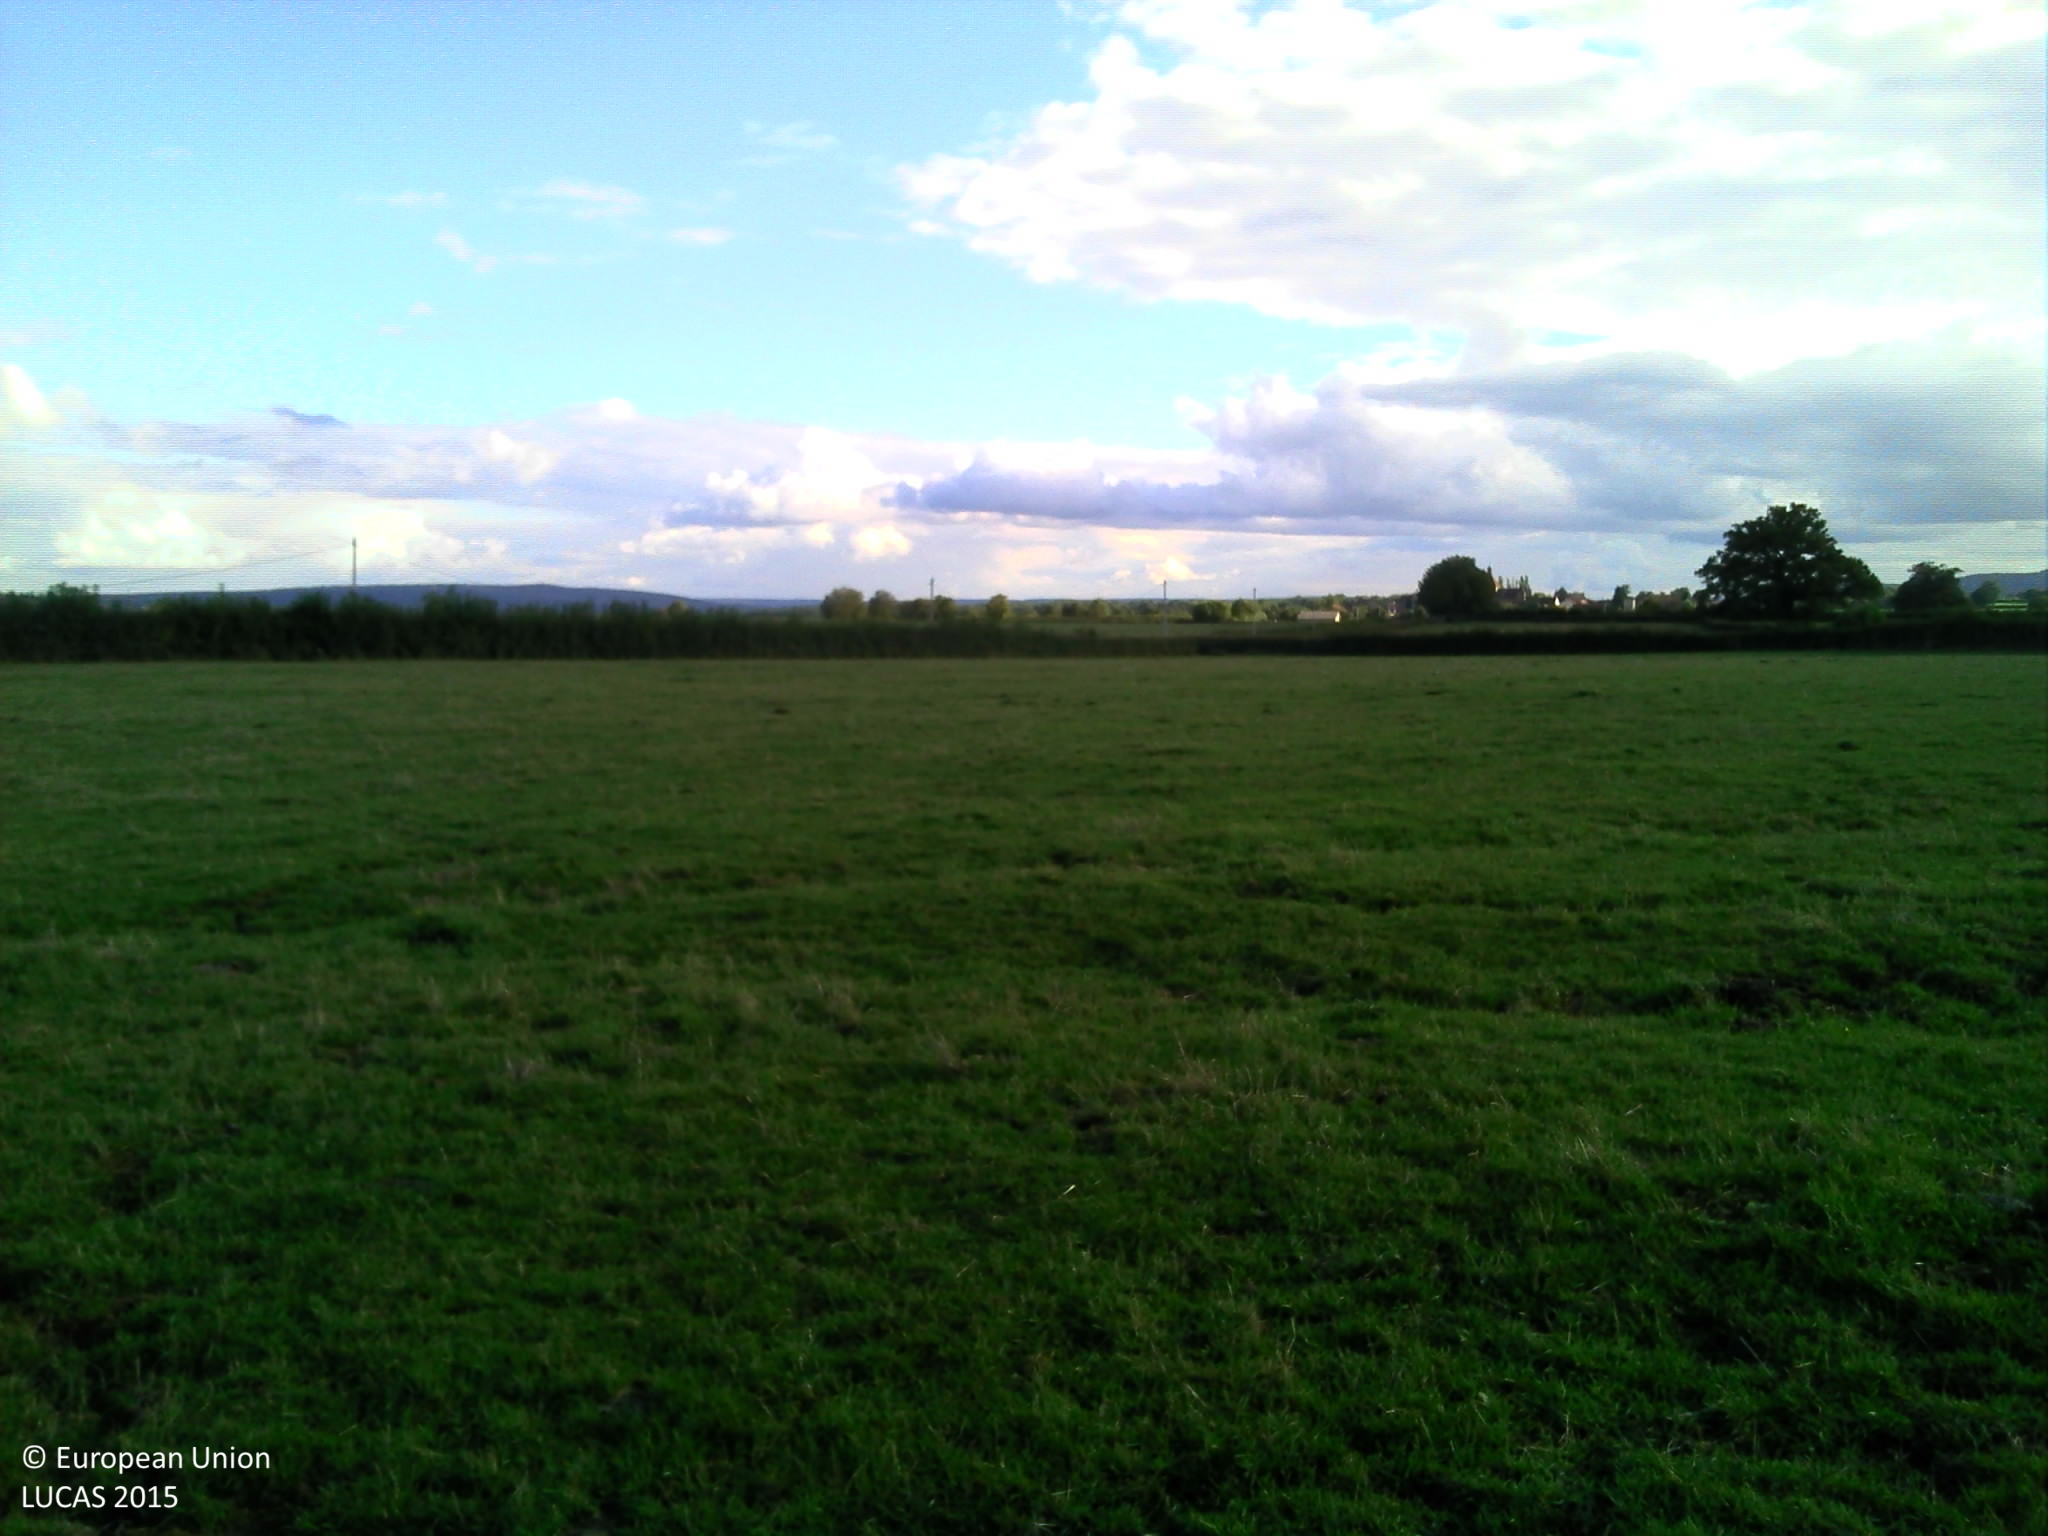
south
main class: Grassland
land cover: Grassland without tree/shrub cover
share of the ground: > 75 %
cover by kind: herbaceous plants 100 %
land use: Agriculture (excluding fallow land and kitchen gardens)
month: September
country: FR
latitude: 47.1401
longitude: 4.3429
